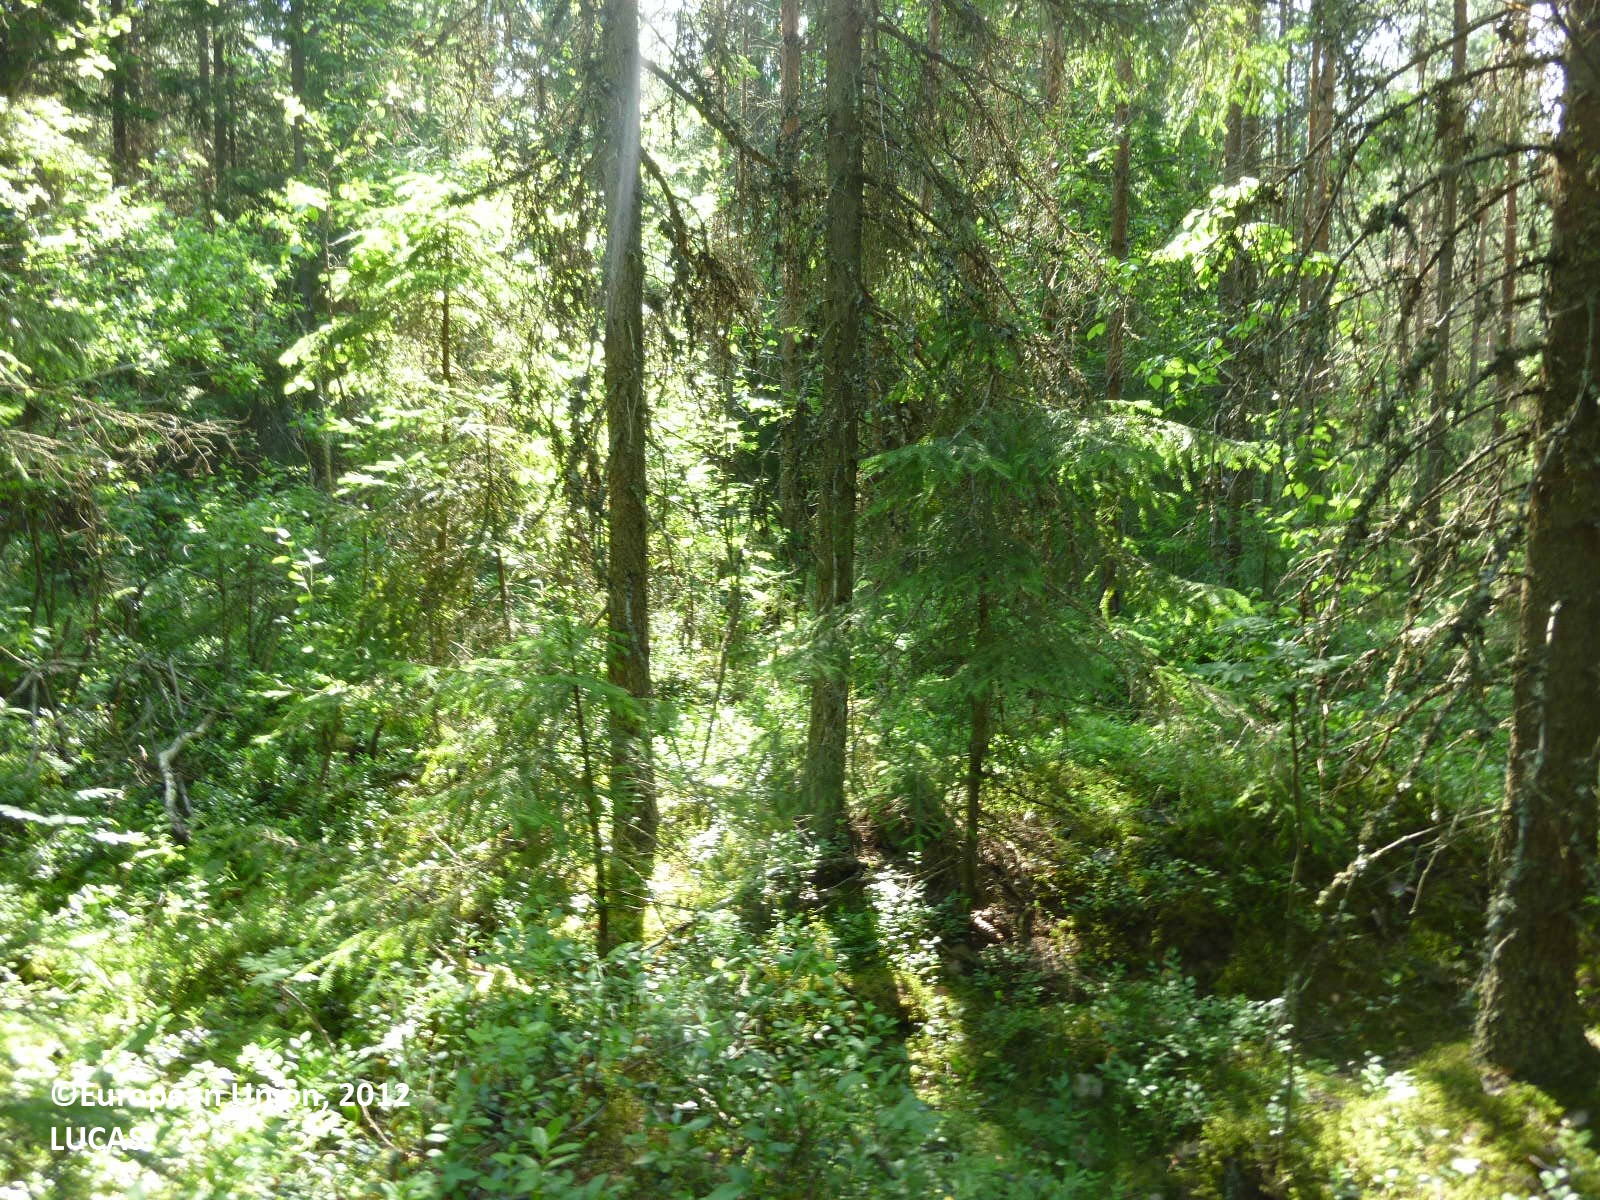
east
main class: Woodland
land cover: Spruce dominated coniferous woodland
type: boreal forest
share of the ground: > 75 %
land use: Forestry
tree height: > 5 m
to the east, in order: Spruce dominated coniferous woodland; Pine dominated coniferous woodland; Grass margins; Paved roads, cycling and walking lanes; Grass margins; Pine dominated mixed woodland; Pine dominated coniferous woodland
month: July
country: FI
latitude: 61.1326
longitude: 22.5634
